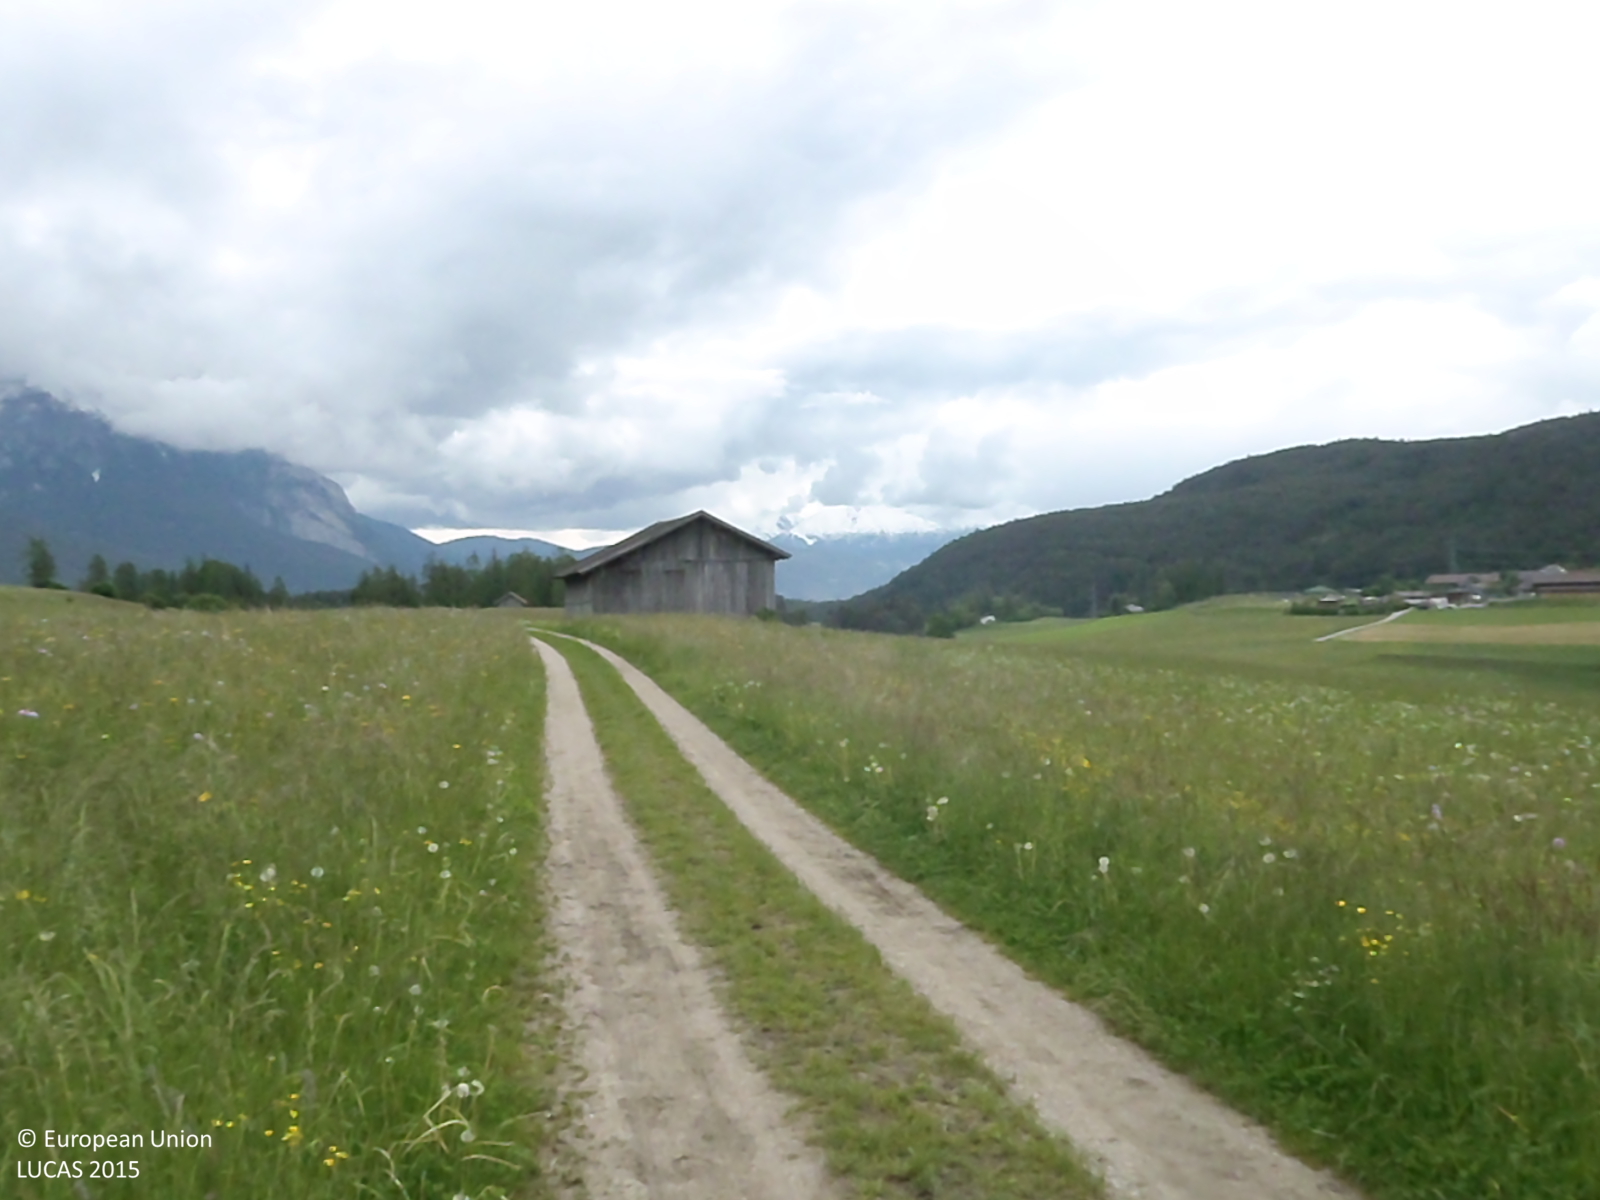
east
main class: Grassland
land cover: Grassland without tree/shrub cover
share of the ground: > 75 %
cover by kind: herbaceous plants 100 %
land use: Agriculture (excluding fallow land and kitchen gardens)
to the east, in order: Grassland without tree/shrub cover; Tracks; Grassland without tree/shrub cover; Artificial constructions in urban areas; Grassland without tree/shrub cover
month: May
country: AT
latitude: 47.3011
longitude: 10.9910
